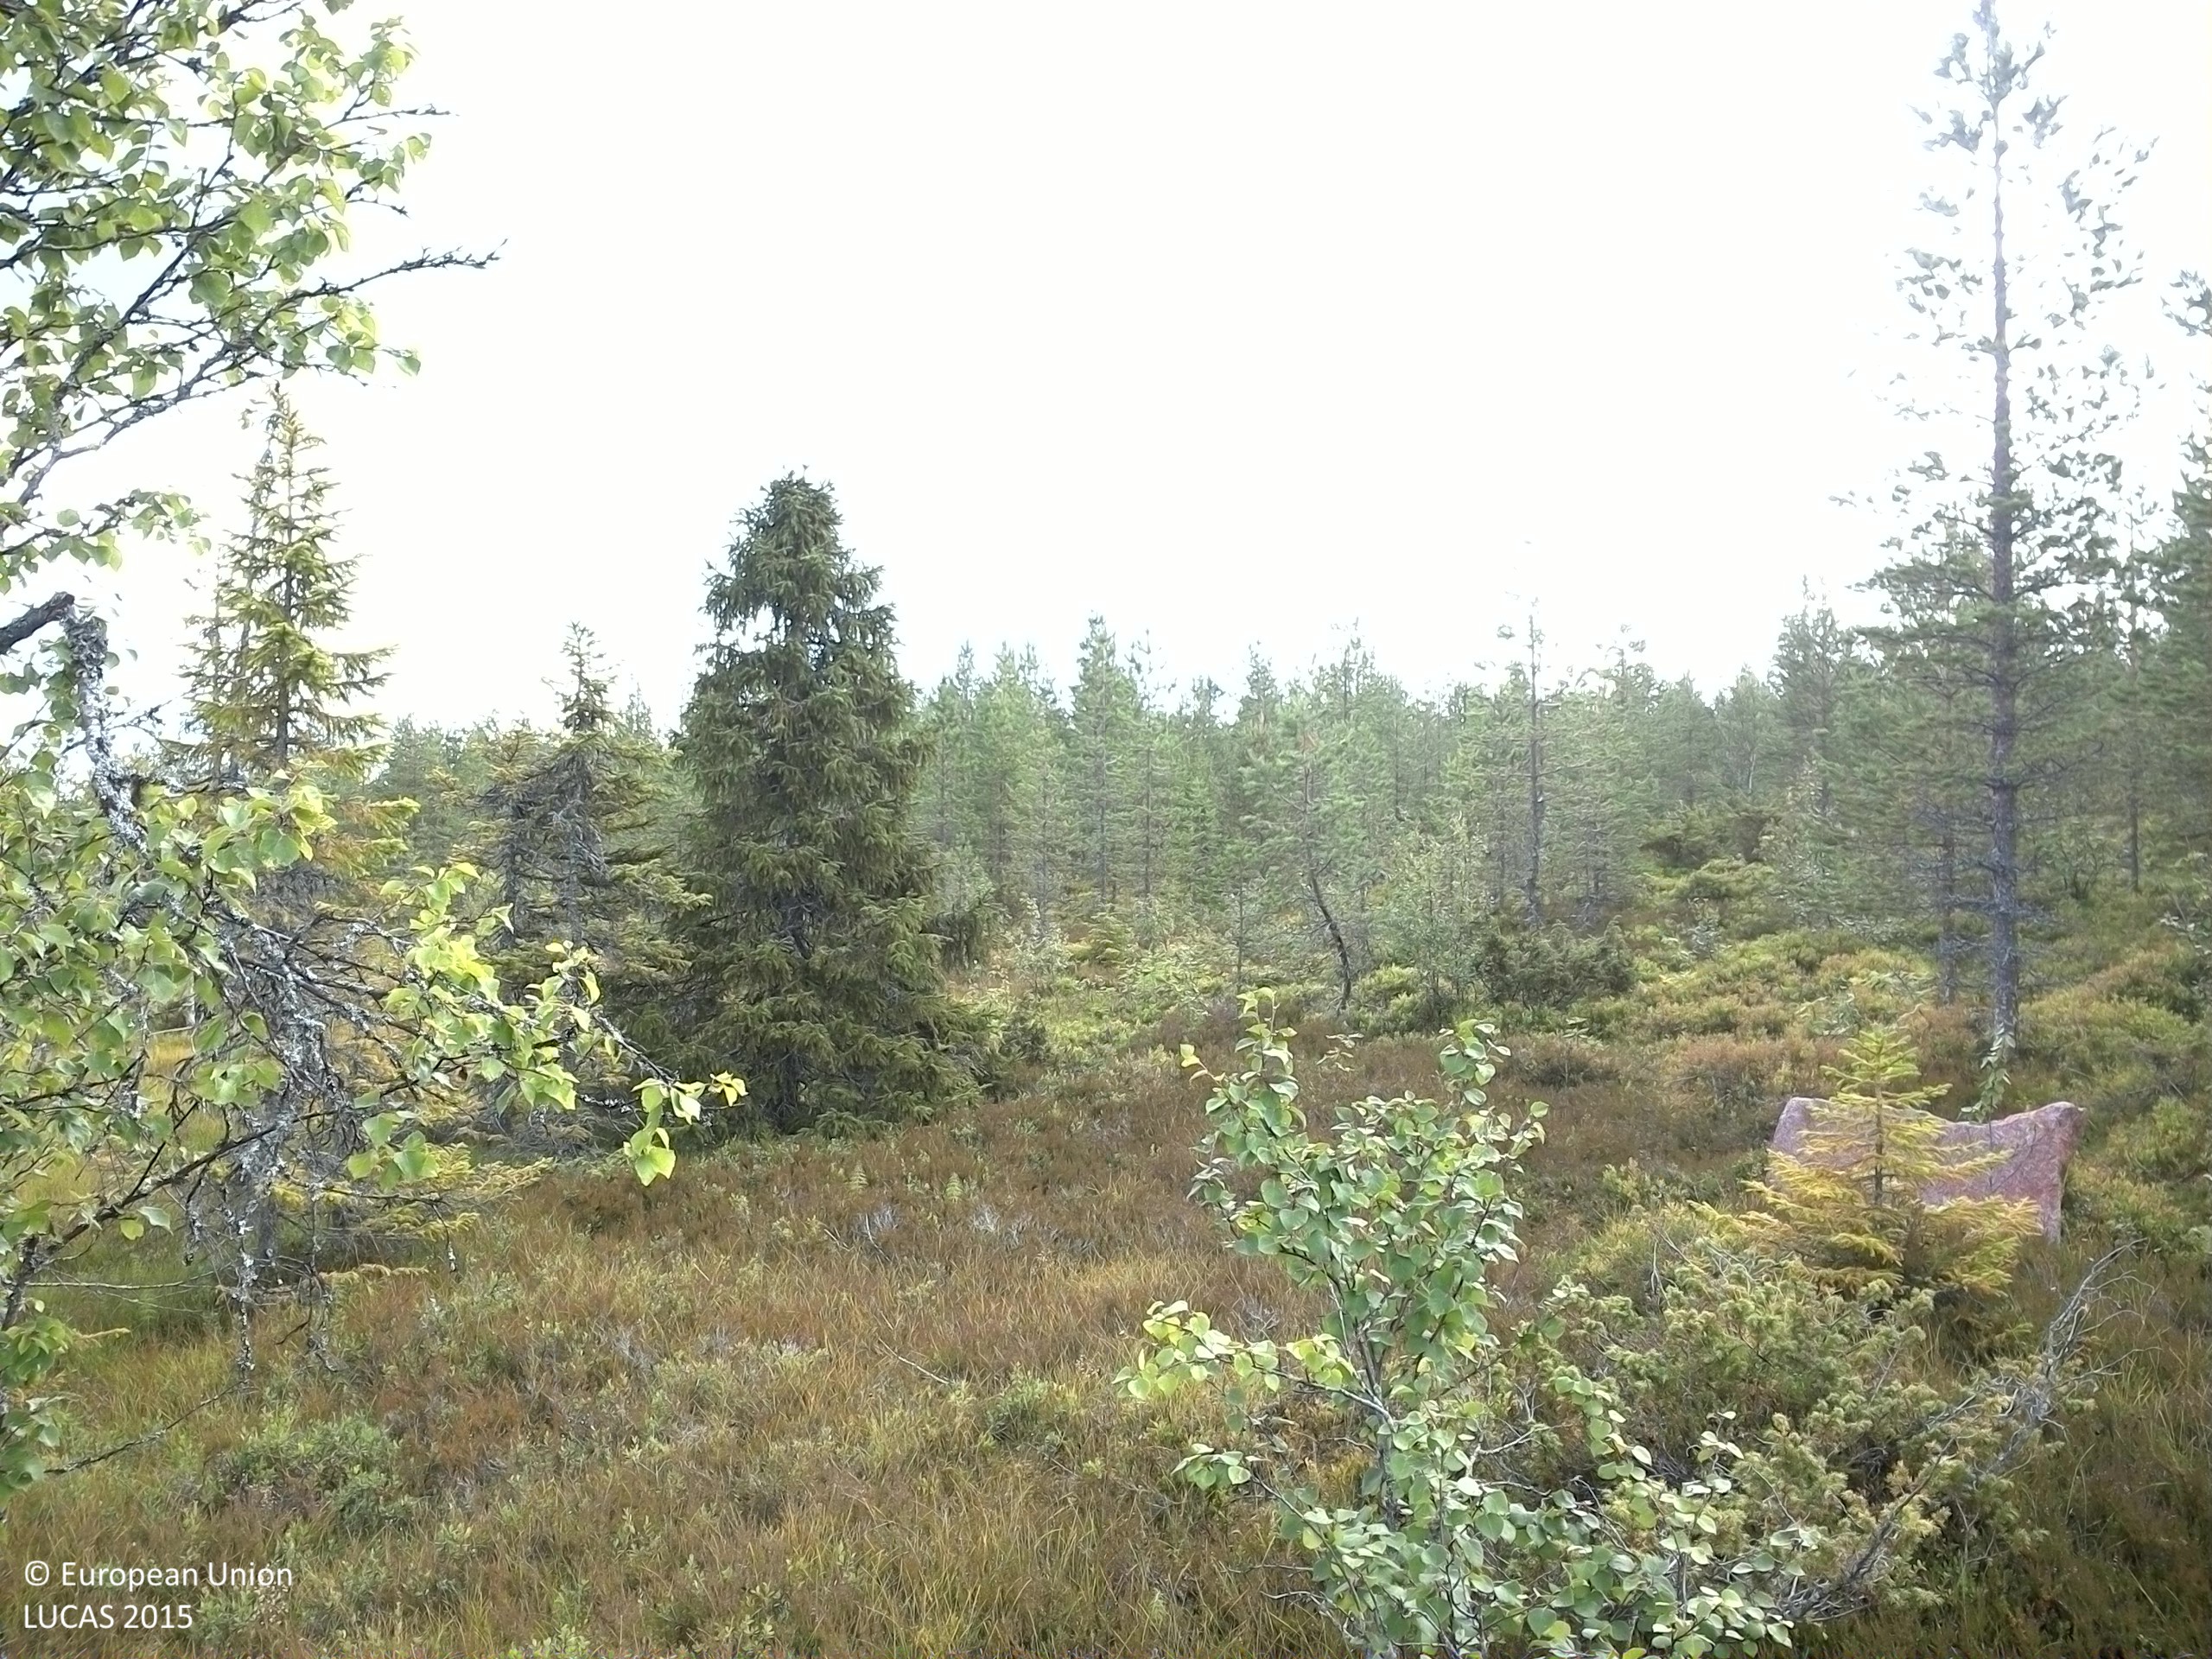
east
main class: Woodland
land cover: Pine dominated coniferous woodland
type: boreal forest
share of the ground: 25 - 50 %
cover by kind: shrubs 65 %, coniferous forest trees 25 %, broadleaved forest trees 5 %, lichens and mosses 5 %
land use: Forestry
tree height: < 5 m
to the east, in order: Pine dominated coniferous woodland
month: August
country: SE
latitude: 63.7573
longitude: 18.0609
